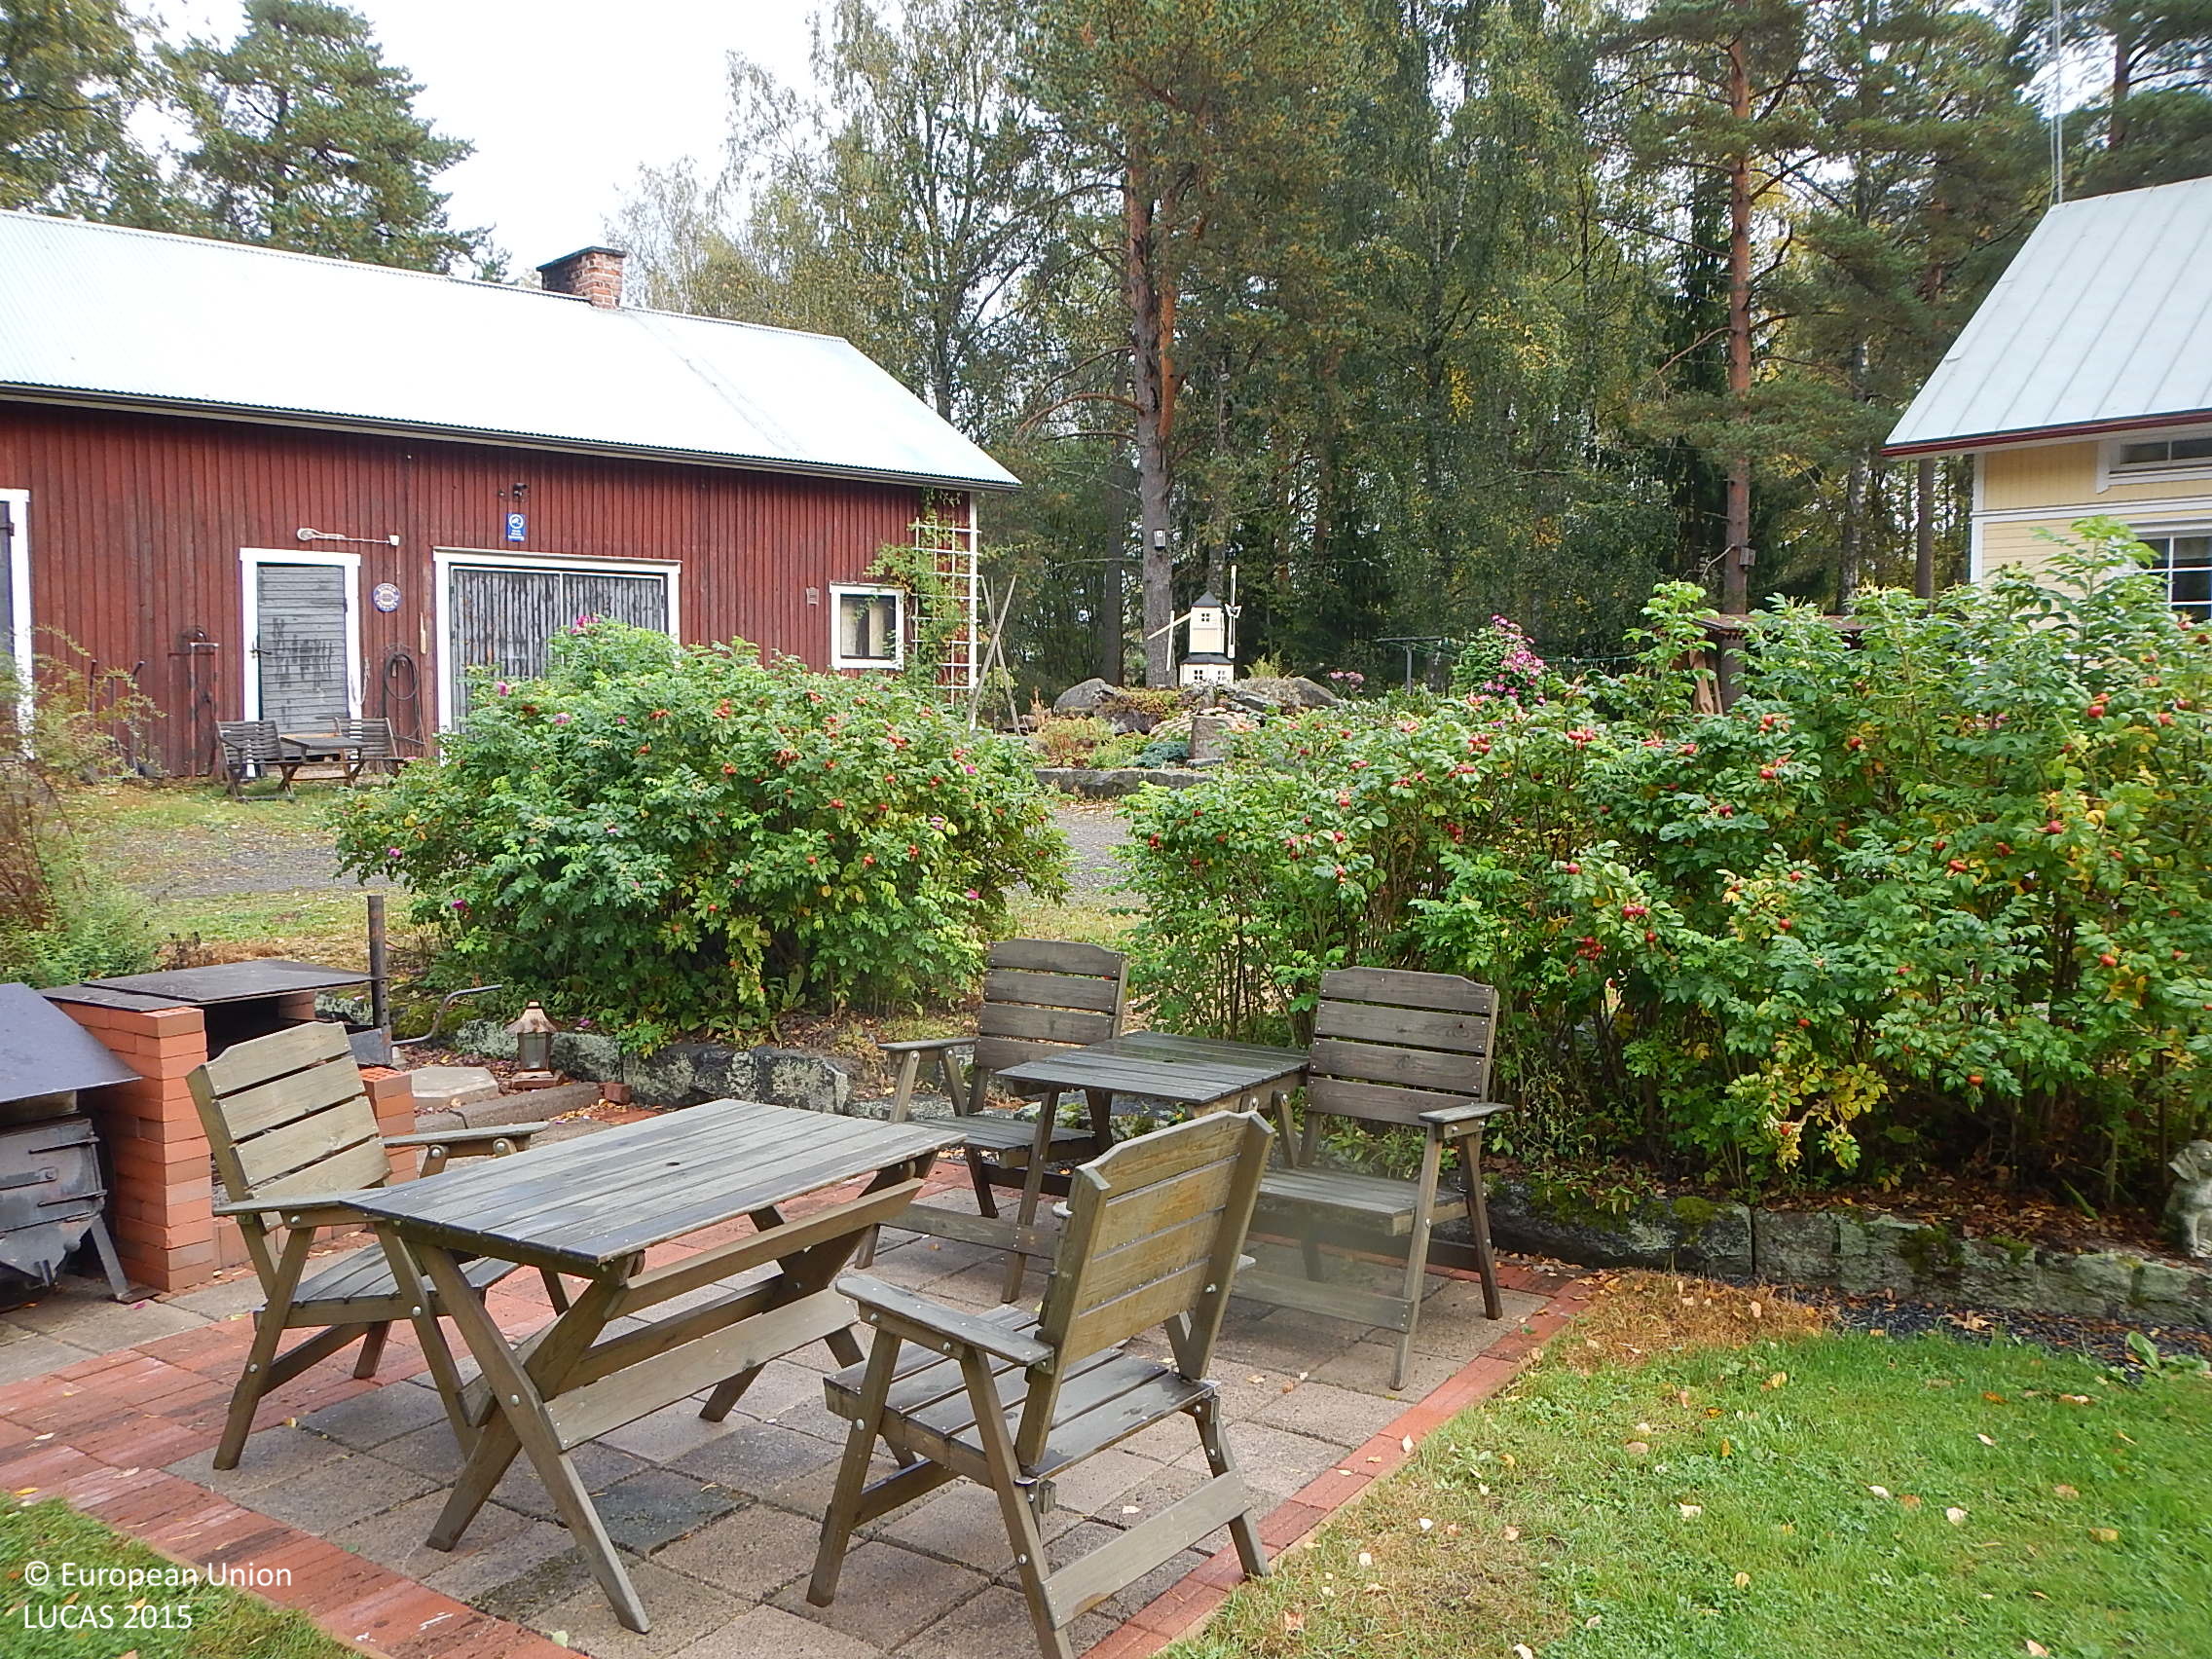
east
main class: Grassland
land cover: Grassland with sparse tree/shrub cover
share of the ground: > 75 %
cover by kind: herbaceous plants 95 %, broadleaved forest trees 5 %
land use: Residential
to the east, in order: Grassland with sparse tree/shrub cover; Artificial constructions in urban areas; Pine dominated mixed woodland; Ditches and canals; Grassland without tree/shrub cover; Spontaneously vegetated surfaces; Electric lines; Abandoned hedges; Railways; Broadleaved woodland; Spontaneously vegetated surfaces; Electric lines; Spontaneously vegetated surfaces; Broadleaved woodland; Artificial constructions in urban areas
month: September
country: FI
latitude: 61.5610
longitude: 21.5899
